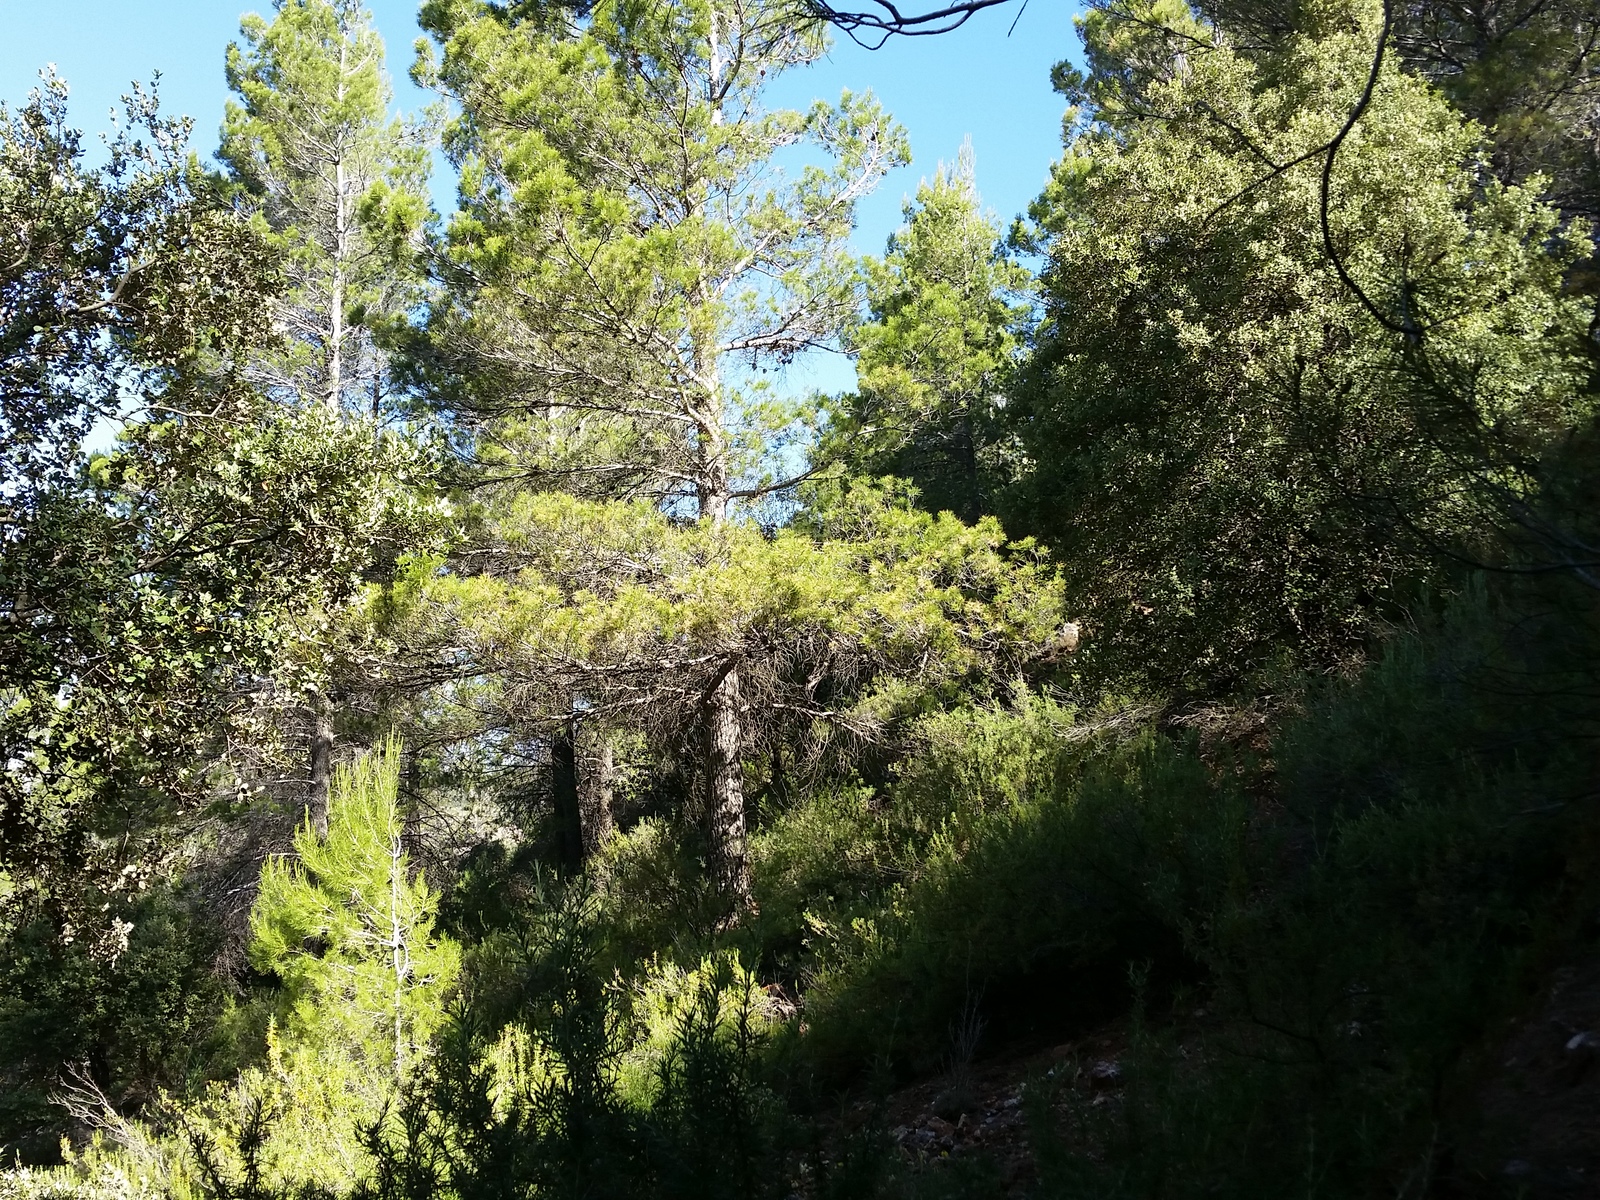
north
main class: Woodland
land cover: Pine dominated coniferous woodland
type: coniferous forest of the mediterranean region
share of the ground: > 75 %
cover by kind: coniferous forest trees 80 %, shrubs 10 %, herbaceous plants 5 %, consolidated bare surface 5 %
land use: Forestry
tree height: > 5 m
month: June
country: ES
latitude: 38.5830
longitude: -2.5246
